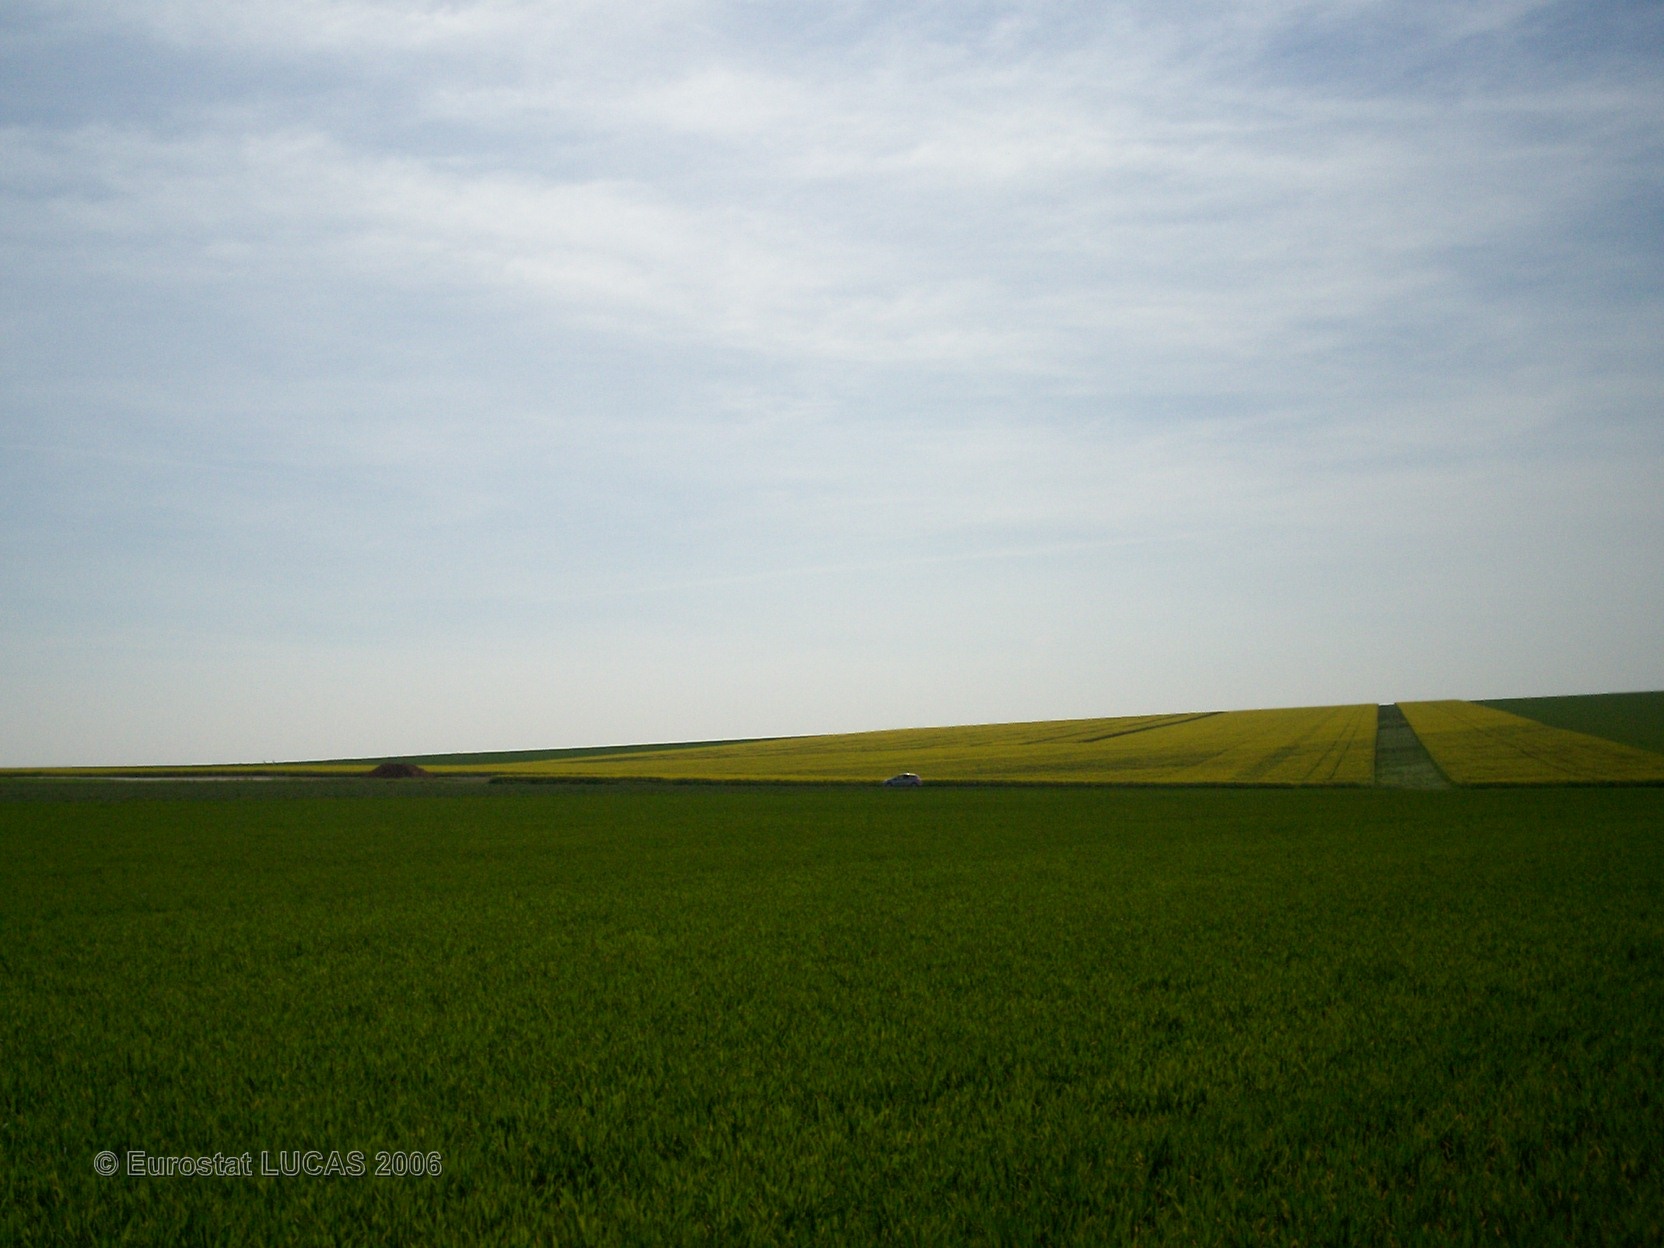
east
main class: Cropland
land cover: Common wheat
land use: Agriculture (excluding fallow land and kitchen gardens)
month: May
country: FR
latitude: 48.8565
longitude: 4.3947
